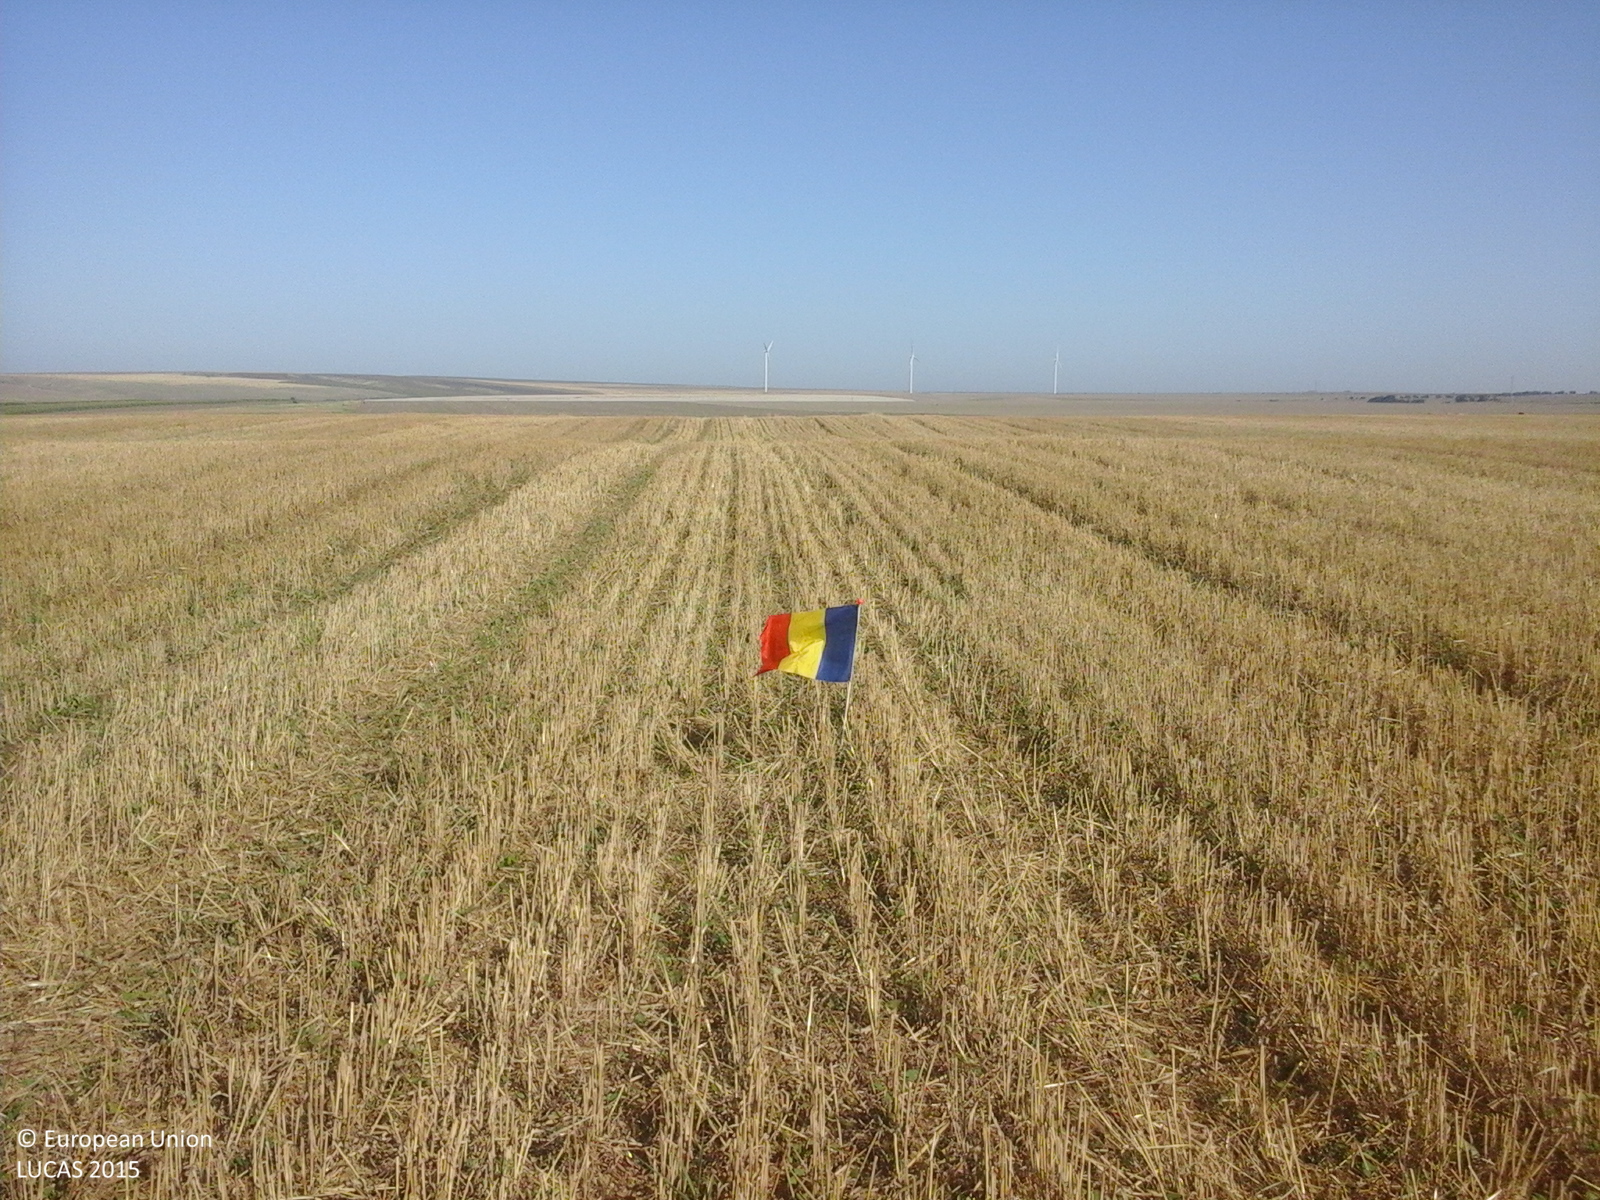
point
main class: Cropland
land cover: Common wheat
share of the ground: > 75 %
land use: Agriculture (excluding fallow land and kitchen gardens)
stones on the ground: < 10 %
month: August
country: RO
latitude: 44.6508
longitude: 28.1583
